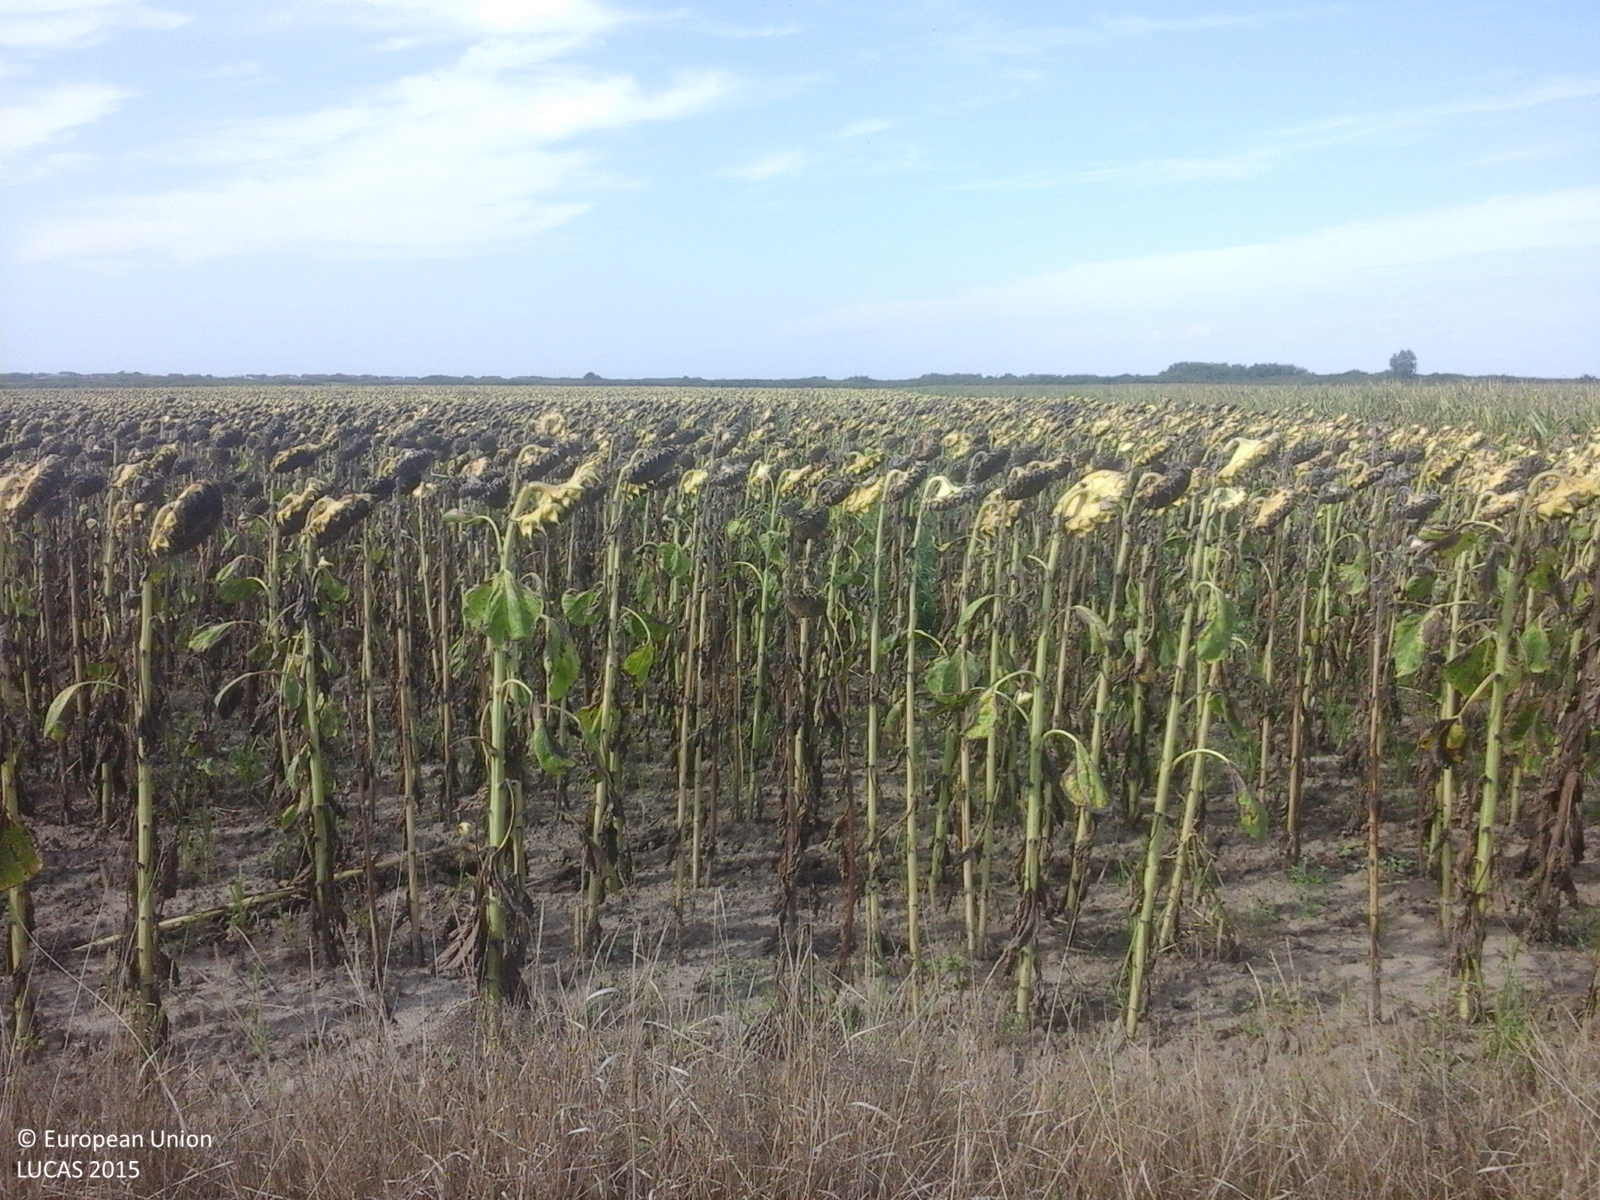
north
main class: Cropland
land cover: Maize
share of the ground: > 75 %
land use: Agriculture (excluding fallow land and kitchen gardens)
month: August
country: RO
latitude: 45.7412
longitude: 21.0431
